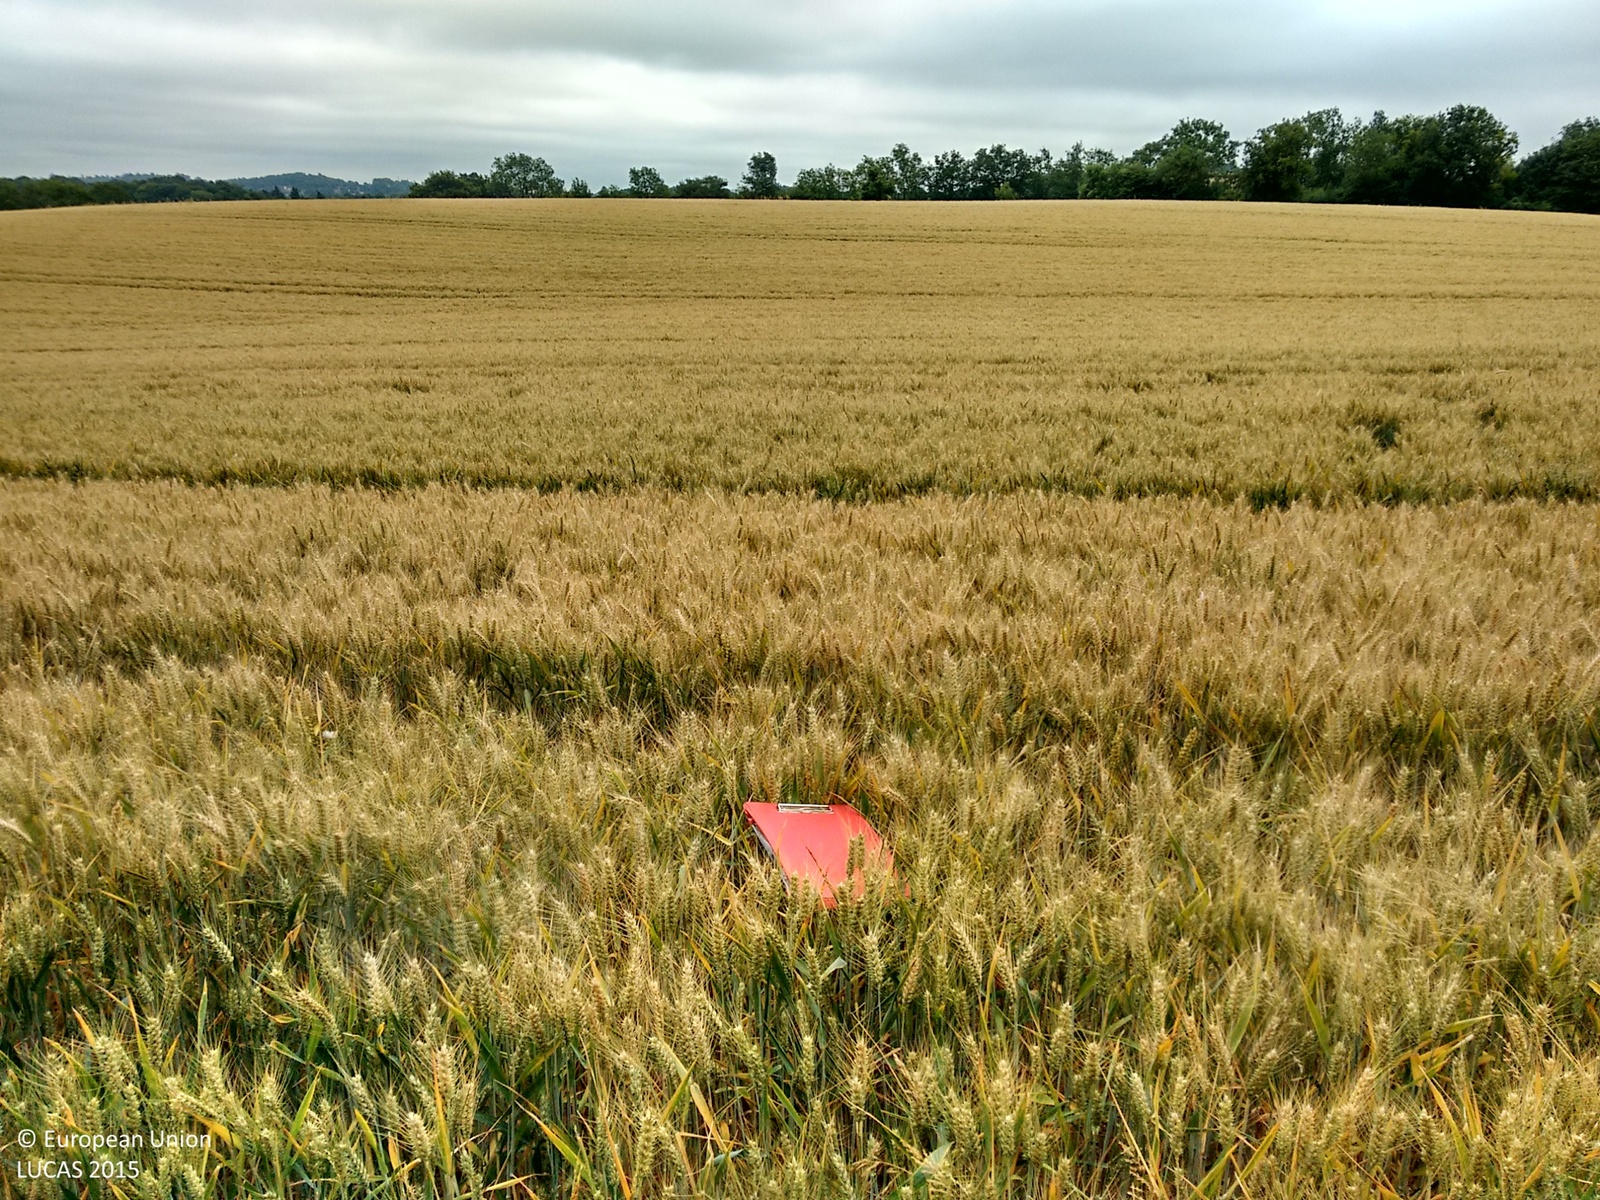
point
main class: Cropland
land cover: Common wheat
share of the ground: > 75 %
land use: Agriculture (excluding fallow land and kitchen gardens)
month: July
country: GB
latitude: 51.2312
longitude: -0.3913
